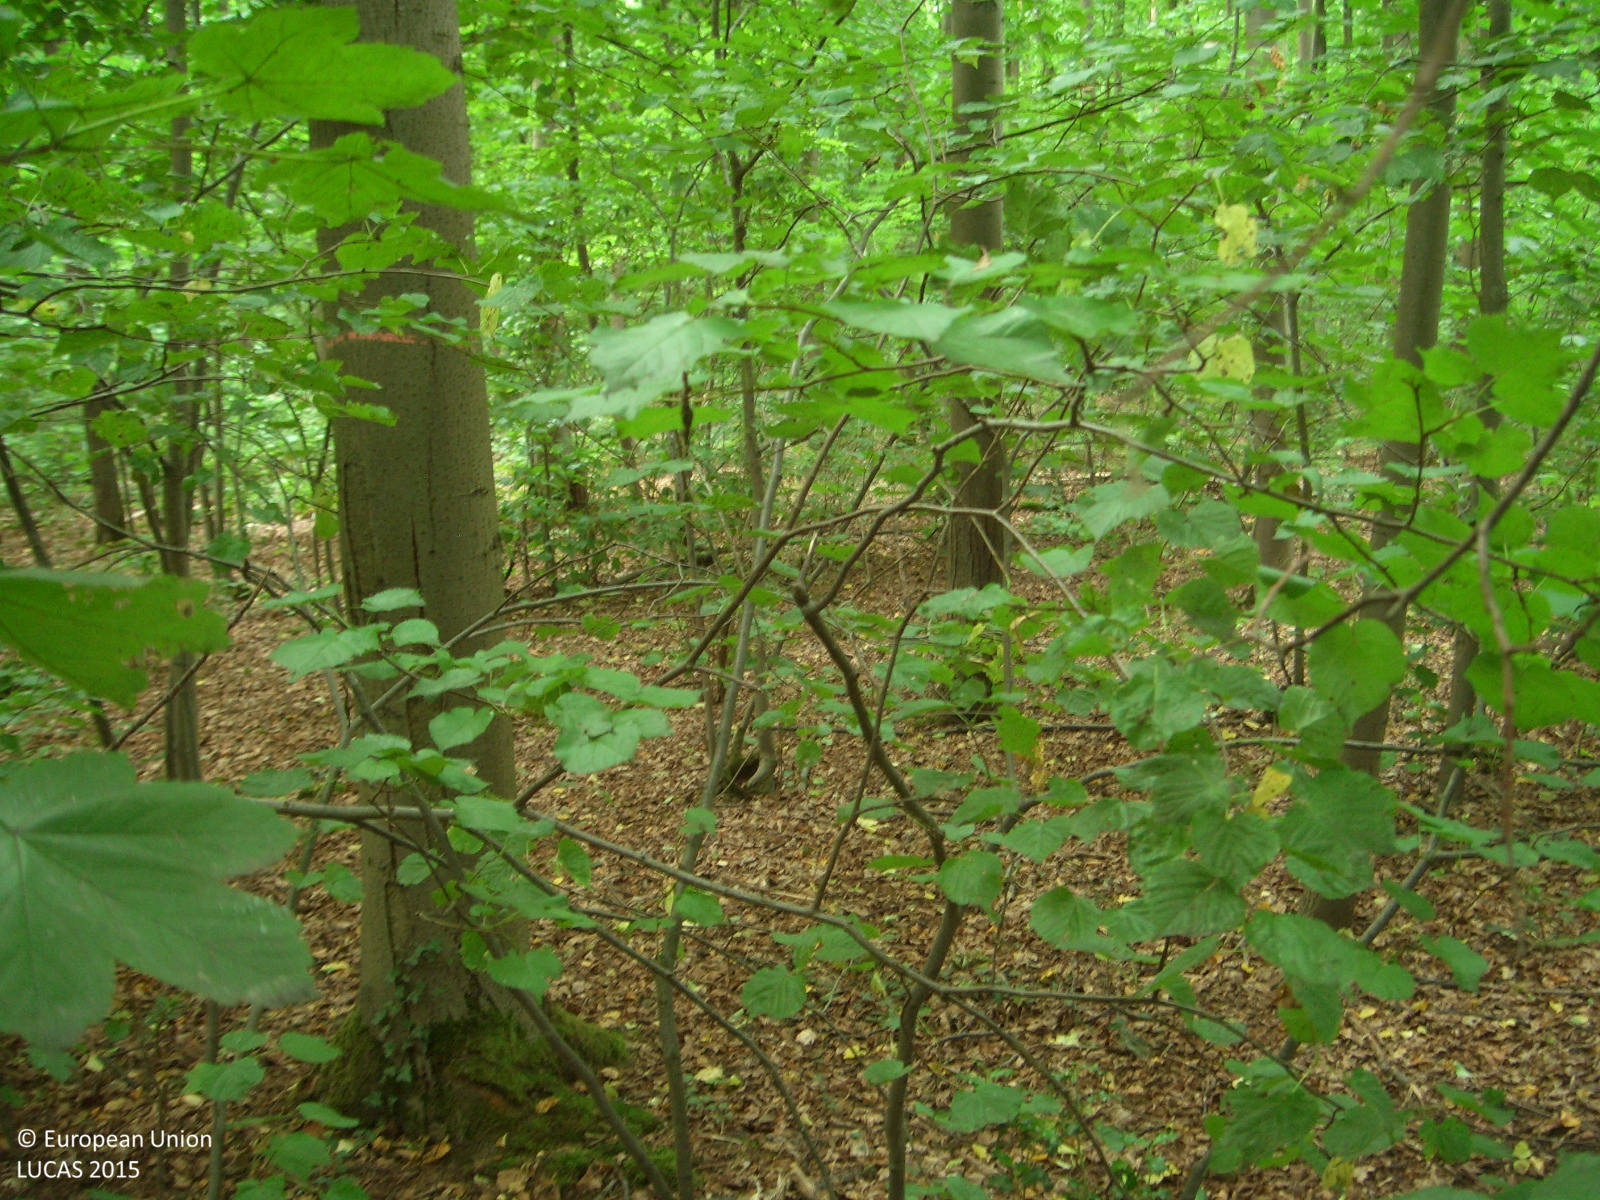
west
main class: Woodland
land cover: Broadleaved woodland
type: mesophytic deciduous forest
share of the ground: > 75 %
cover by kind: broadleaved forest trees 95 %, unconsolidated bare surface 5 %
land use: Forestry
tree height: > 5 m
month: June
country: DE
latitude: 50.9918
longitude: 7.0508
